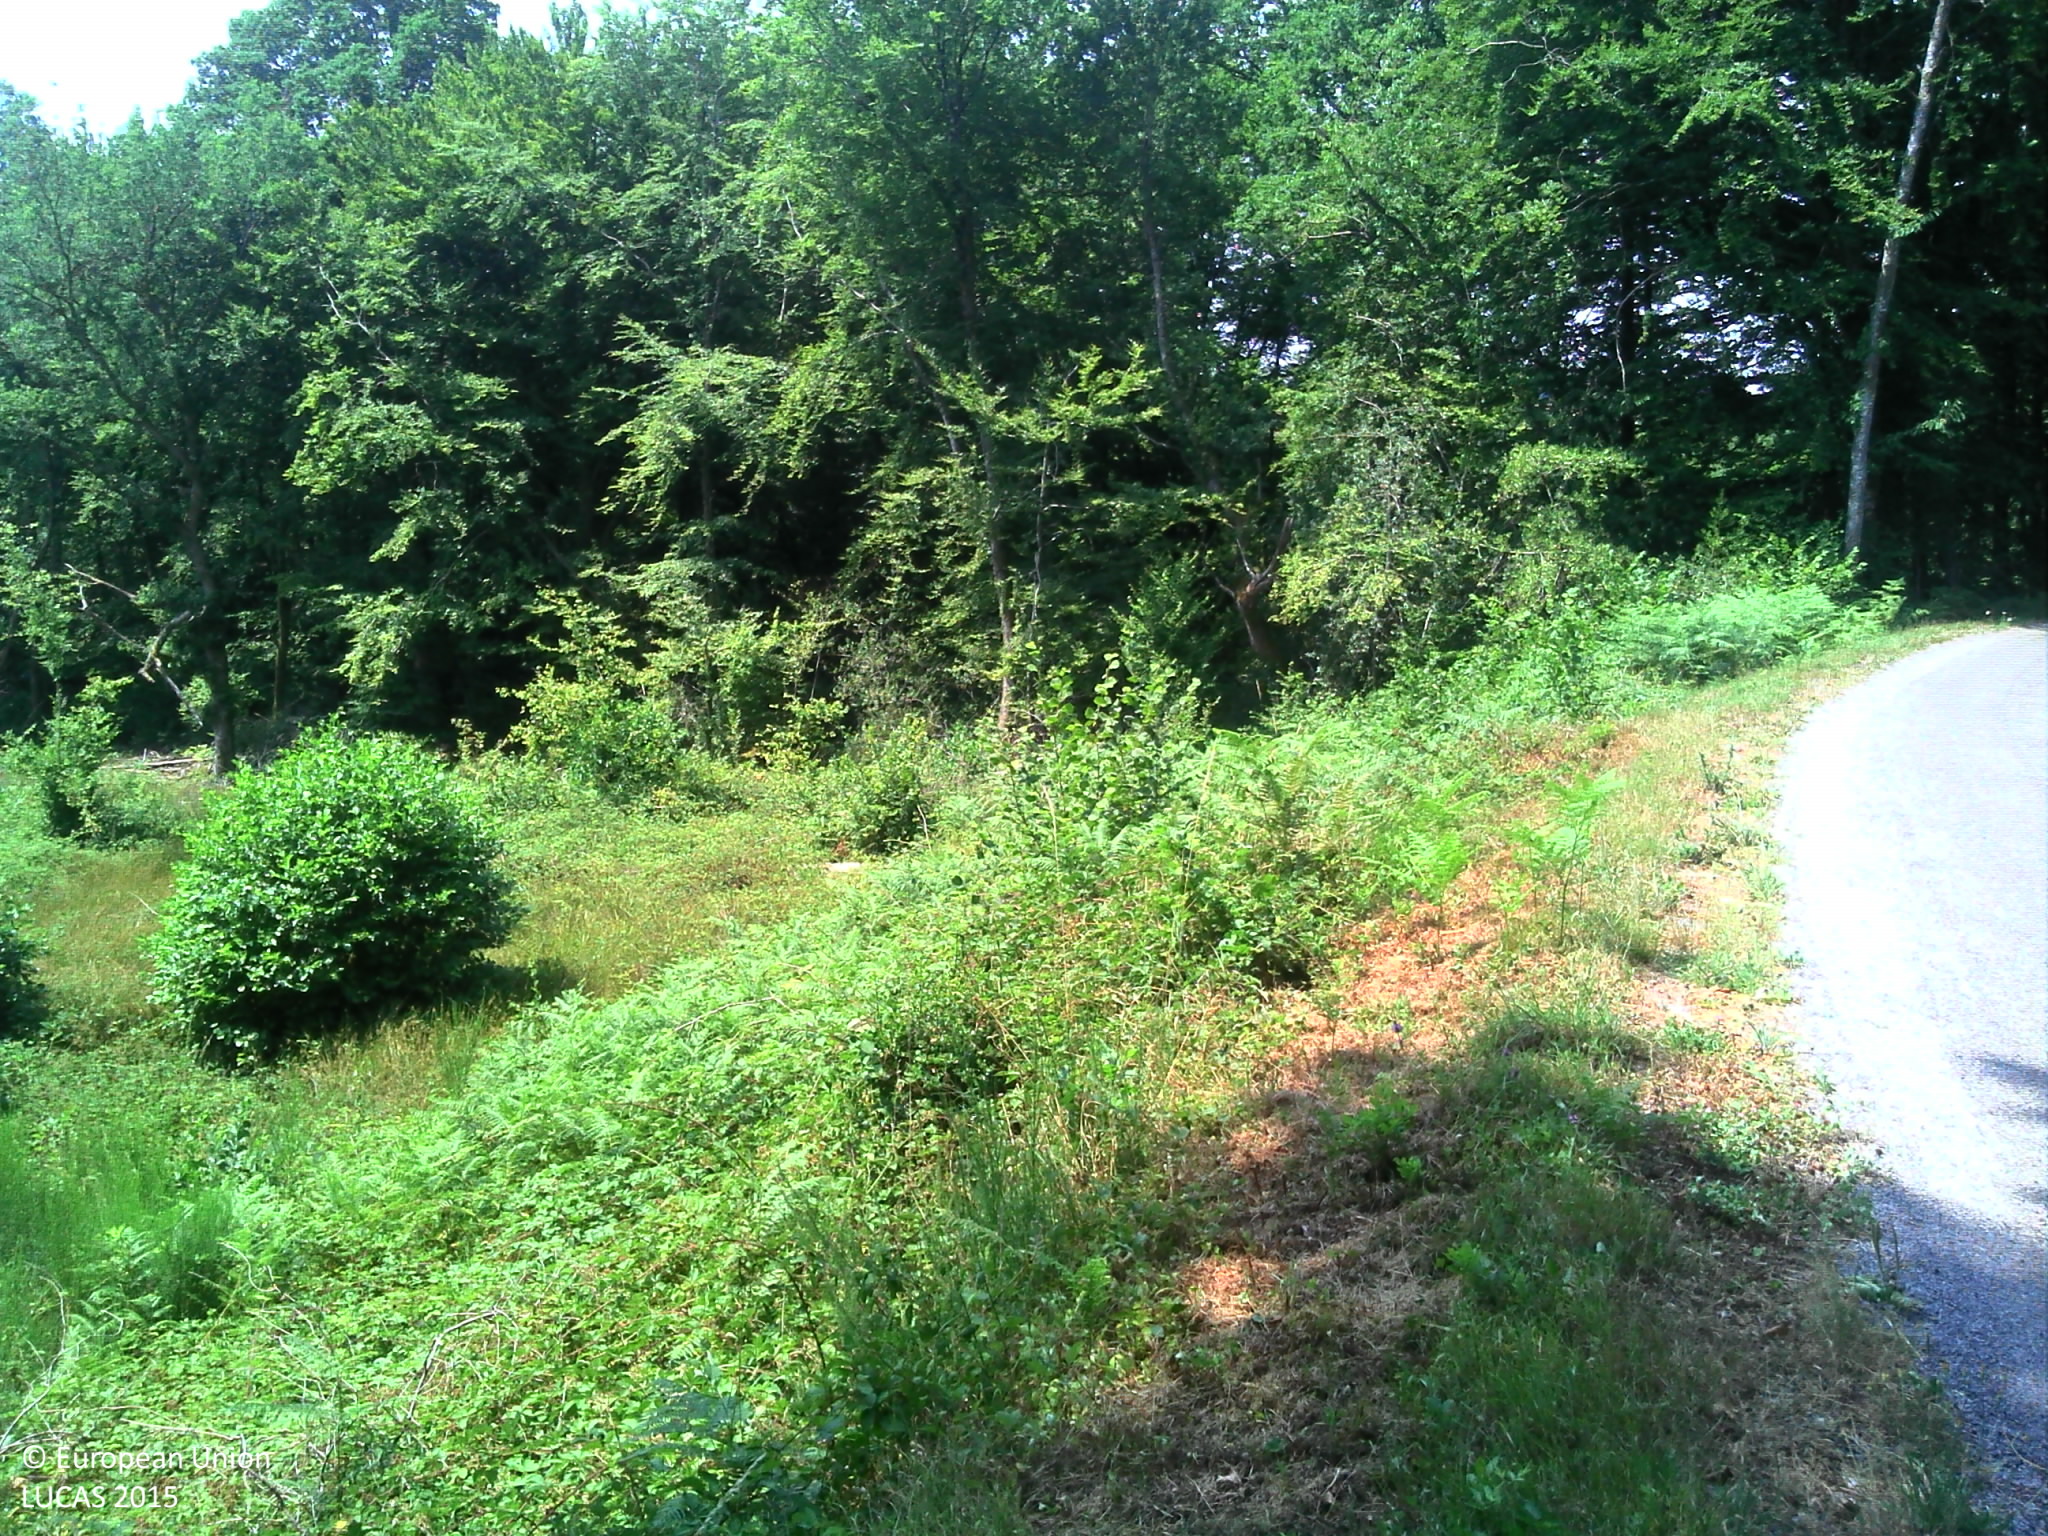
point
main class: Shrubland
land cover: Shrubland with sparse tree cover
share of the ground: > 75 %
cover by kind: shrubs 75 %, herbaceous plants 20 %, broadleaved forest trees 5 %
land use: Forestry
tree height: < 5 m
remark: Clear cut
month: July
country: FR
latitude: 46.0510
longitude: 1.7601
